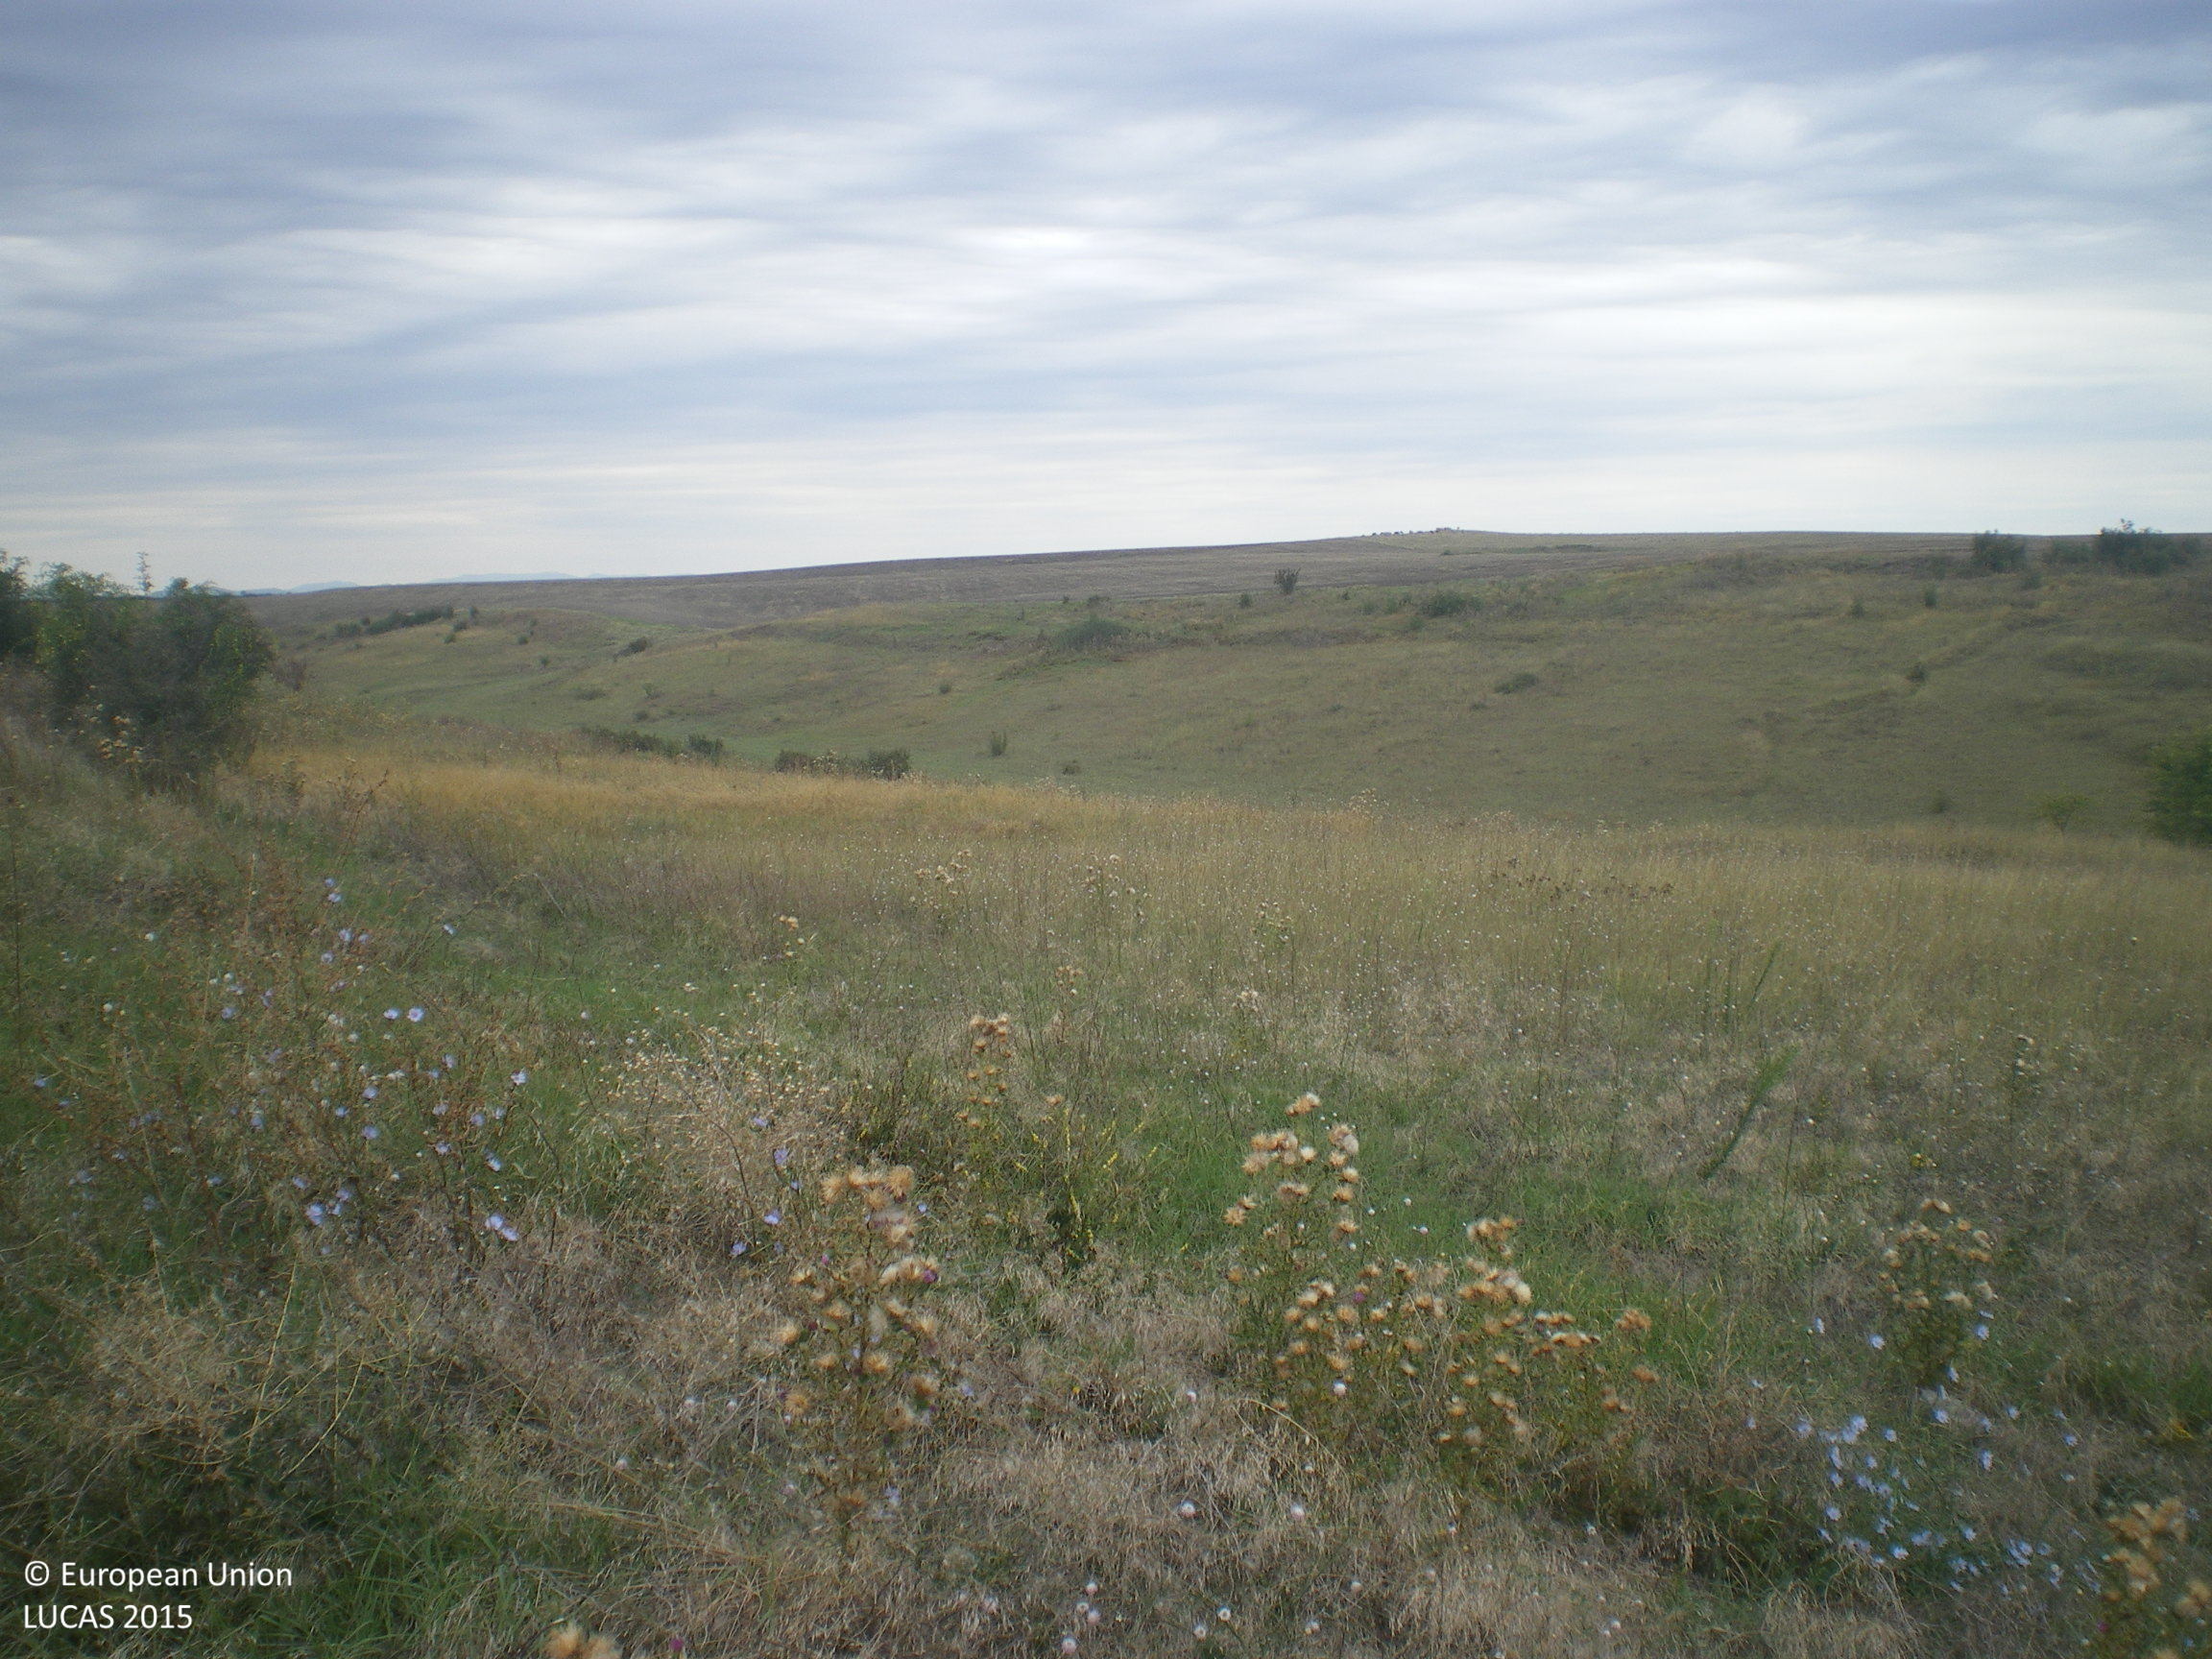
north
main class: Grassland
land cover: Grassland without tree/shrub cover
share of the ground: > 75 %
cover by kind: herbaceous plants 100 %
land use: Agriculture (excluding fallow land and kitchen gardens)
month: September
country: BG
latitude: 42.2066
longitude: 25.9550
